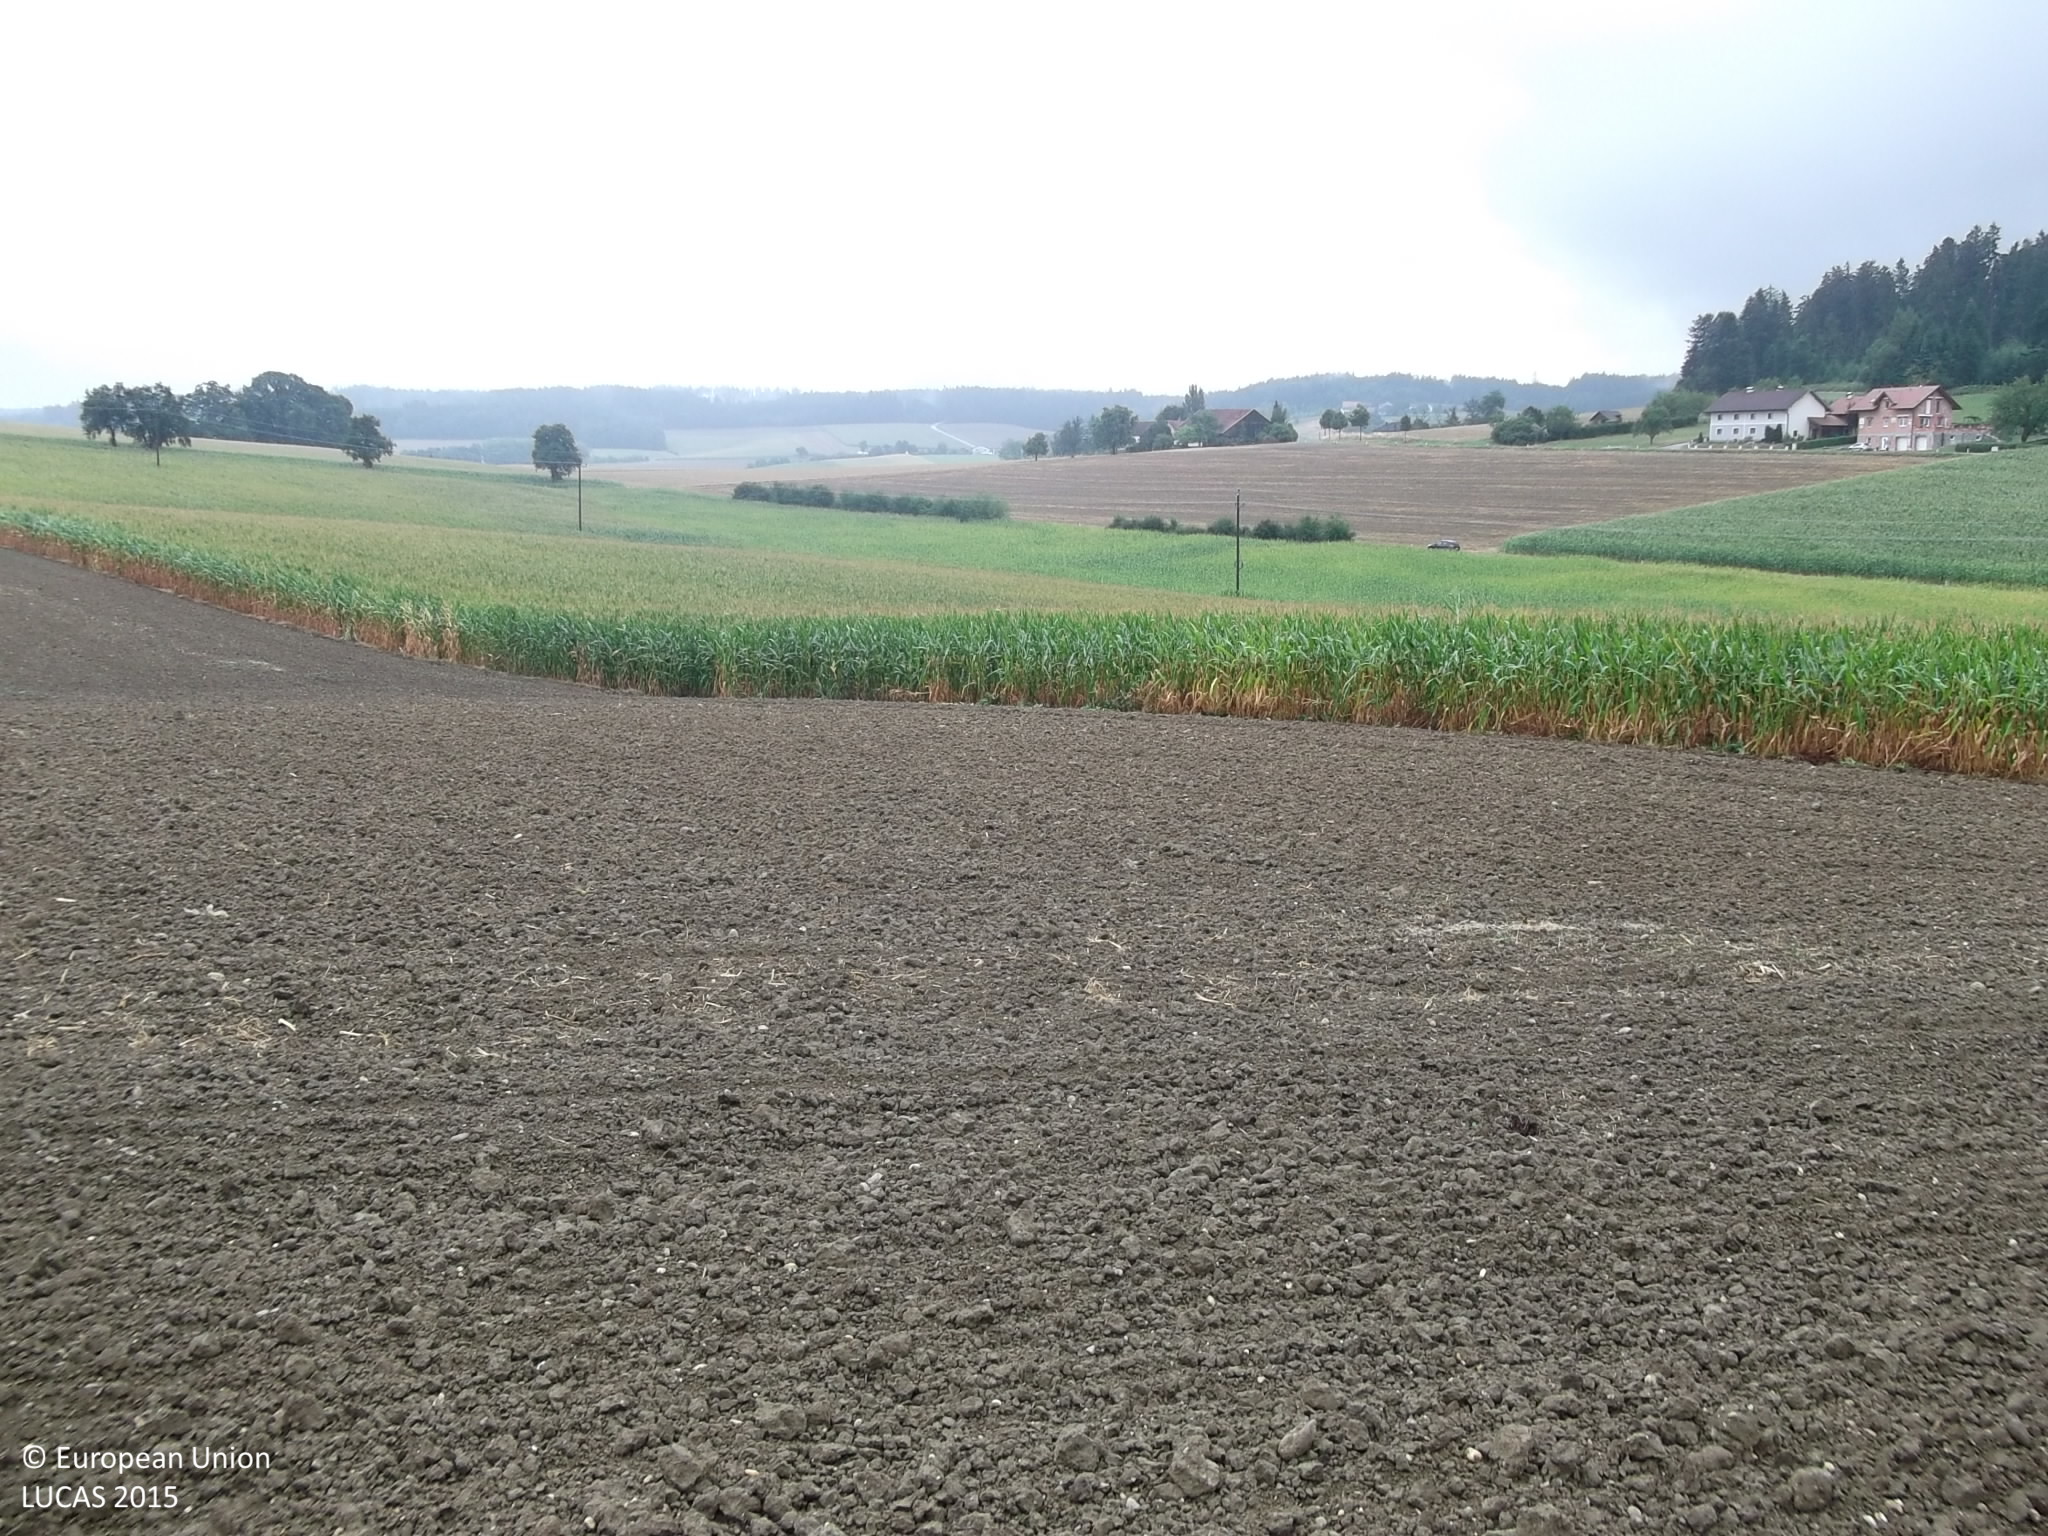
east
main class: Cropland
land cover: Maize
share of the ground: > 75 %
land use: Agriculture (excluding fallow land and kitchen gardens)
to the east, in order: Maize; Grass margins; Maize
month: August
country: AT
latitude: 48.2446
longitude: 13.3523
